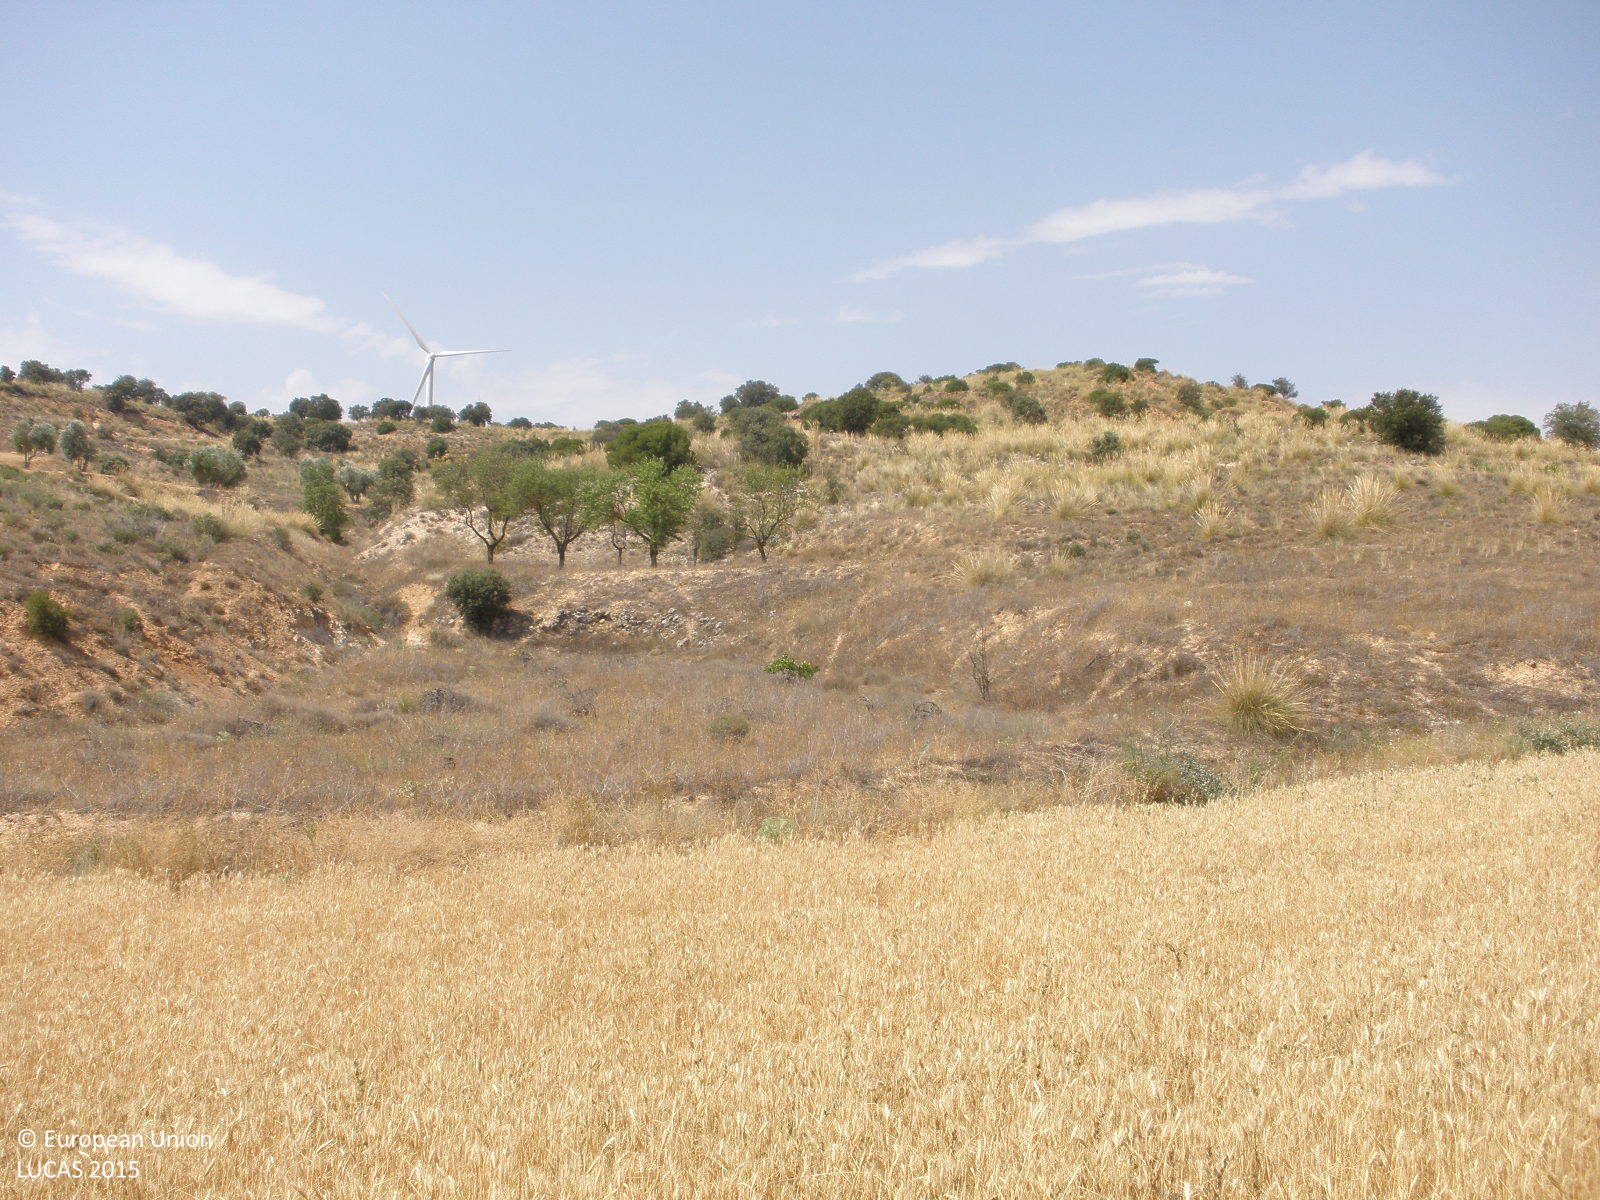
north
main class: Cropland
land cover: Common wheat
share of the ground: > 75 %
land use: Agriculture (excluding fallow land and kitchen gardens)
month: July
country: ES
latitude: 39.9922
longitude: -3.3439
